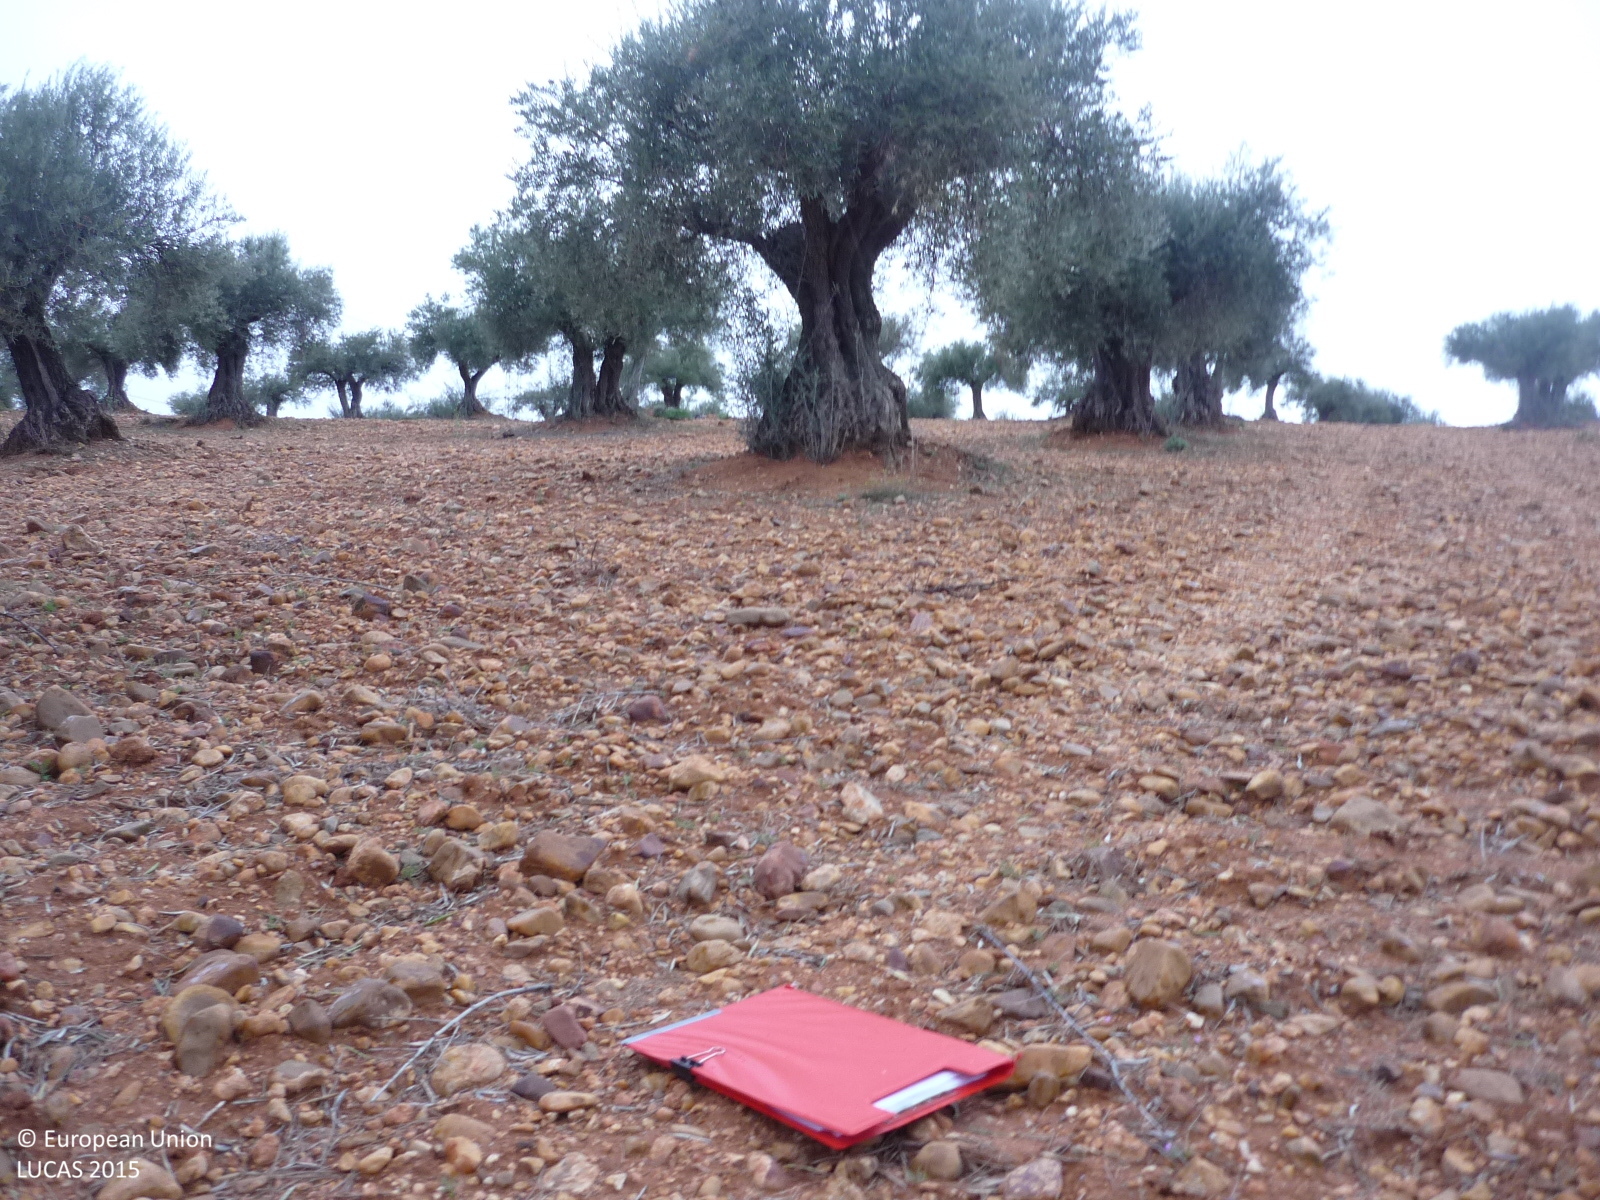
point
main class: Cropland
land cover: Olive groves
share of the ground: 10 - 25 %
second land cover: Other bare soil
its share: > 75 %
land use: Agriculture (excluding fallow land and kitchen gardens)
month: April
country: ES
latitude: 40.3721
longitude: -3.3766
